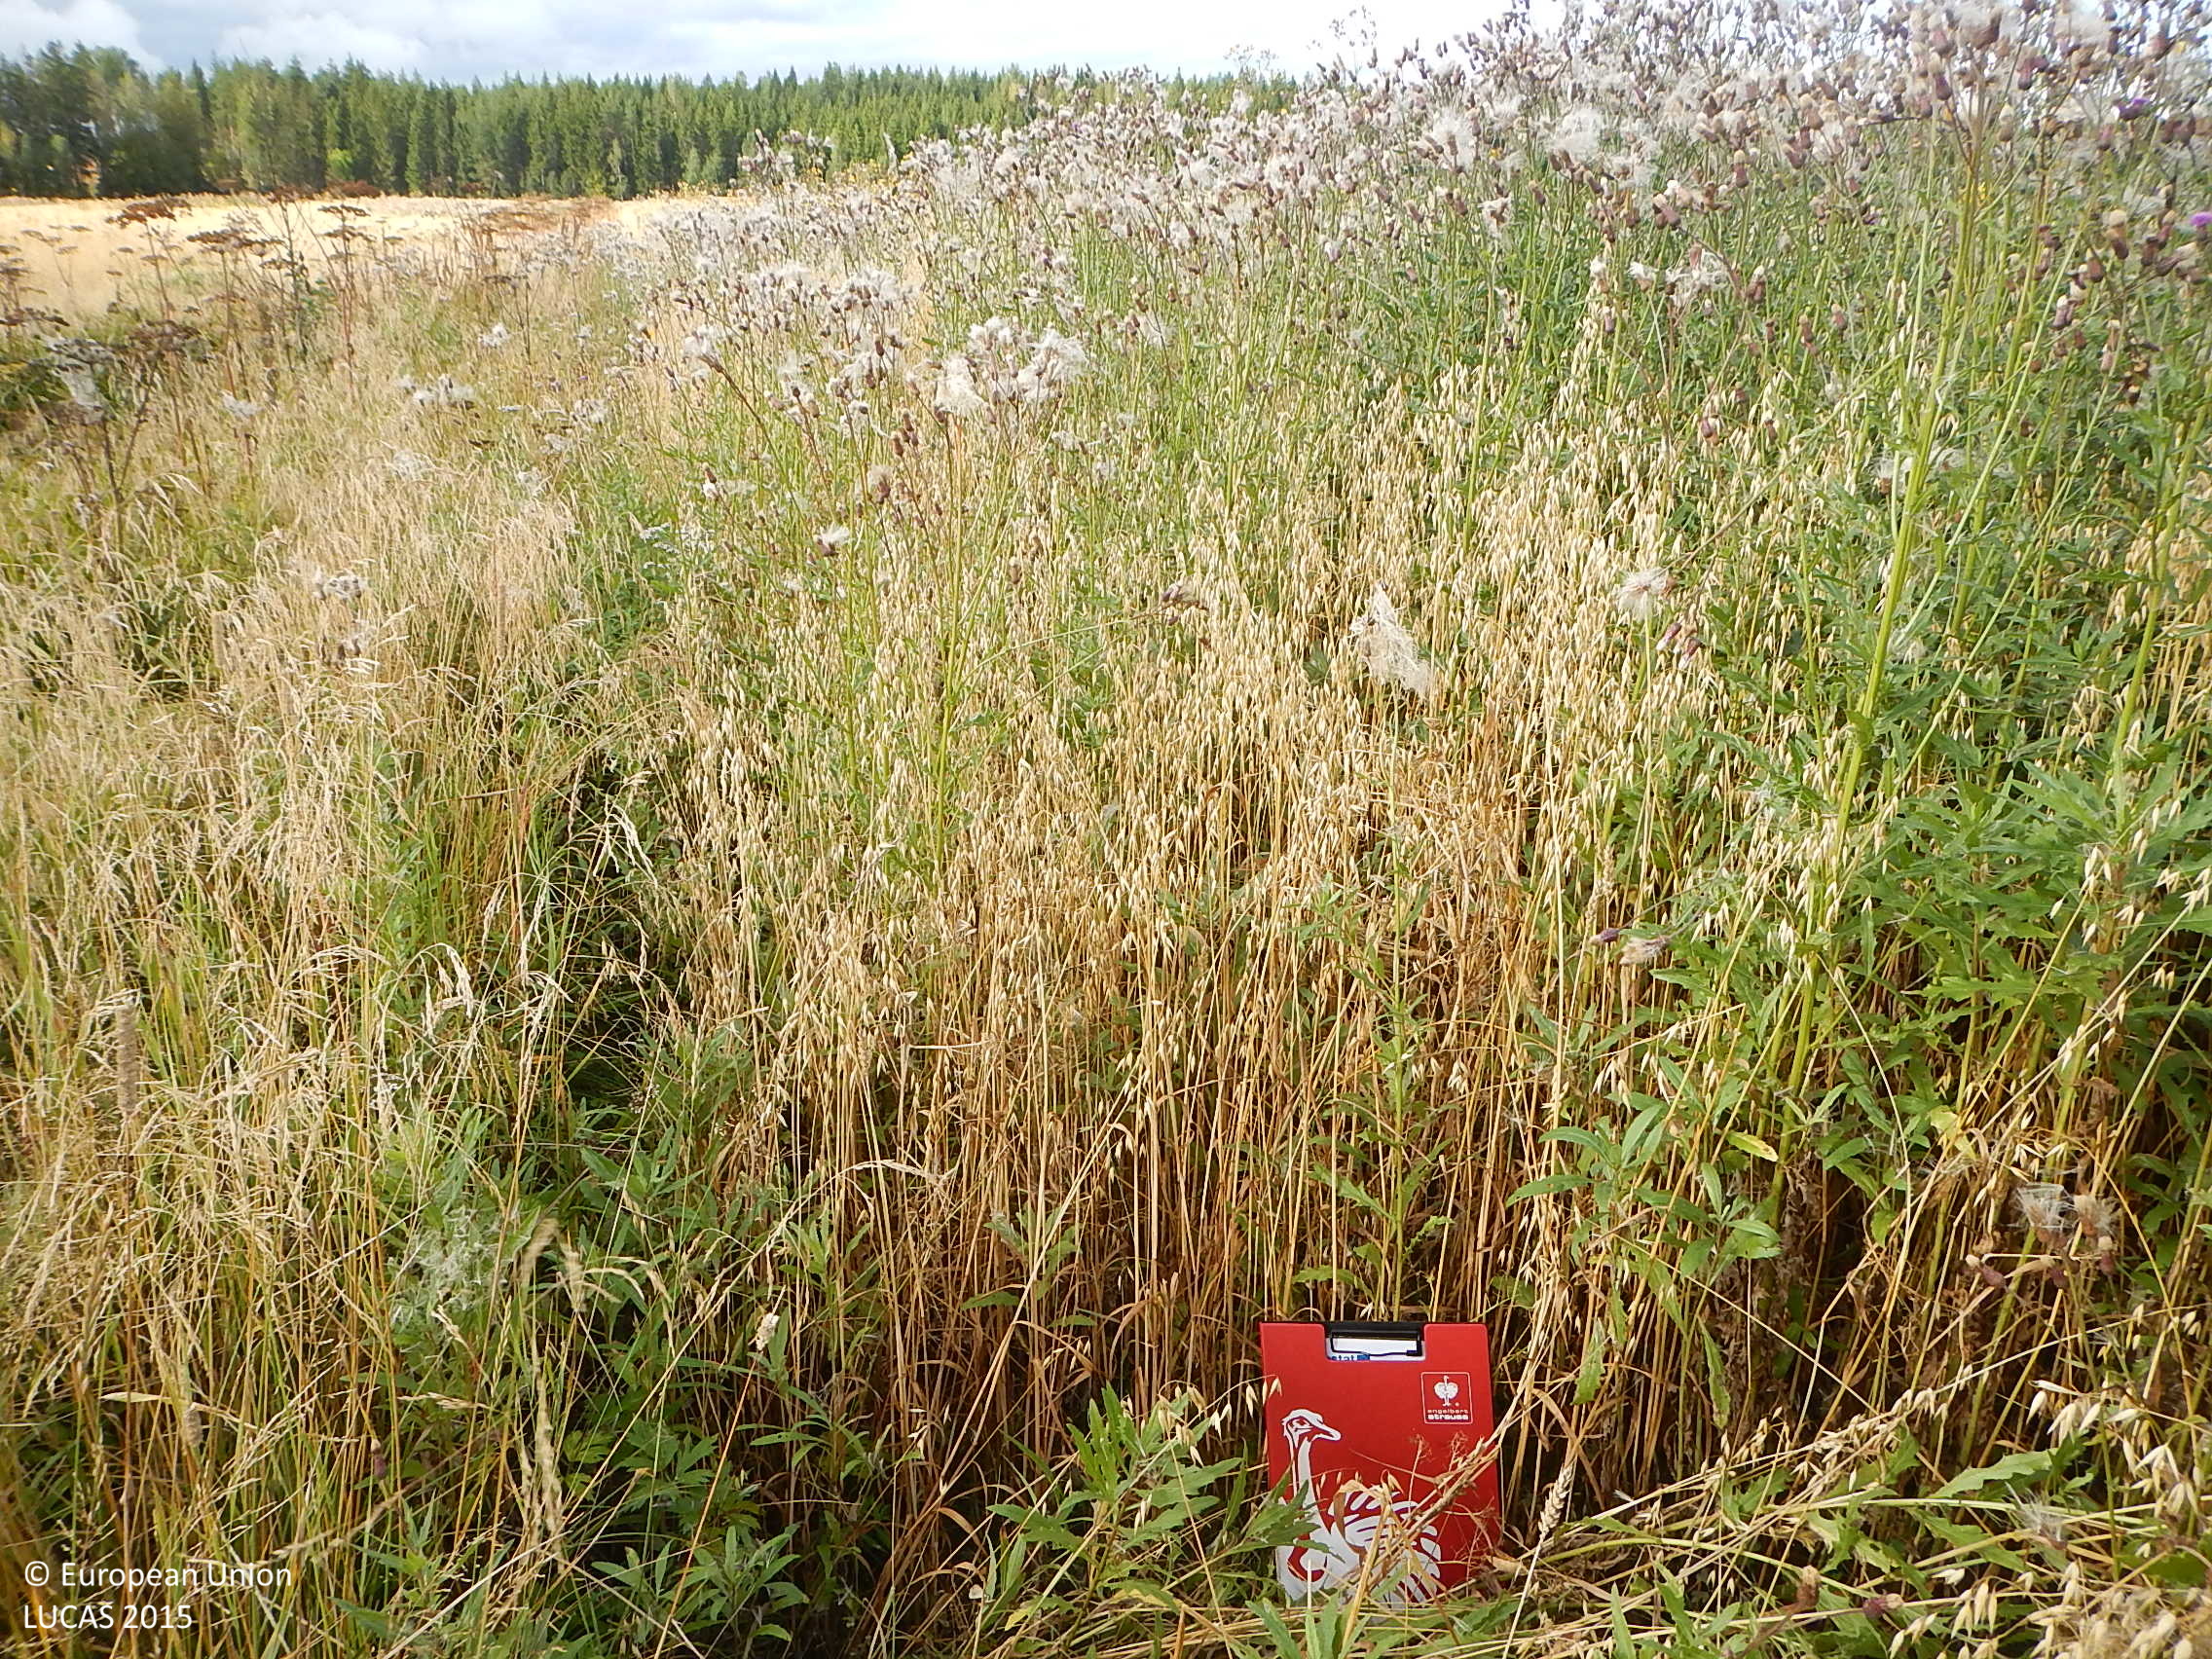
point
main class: Cropland
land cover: Oats
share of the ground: > 75 %
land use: Agriculture (excluding fallow land and kitchen gardens)
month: September
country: FI
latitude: 61.4156
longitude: 22.0299
